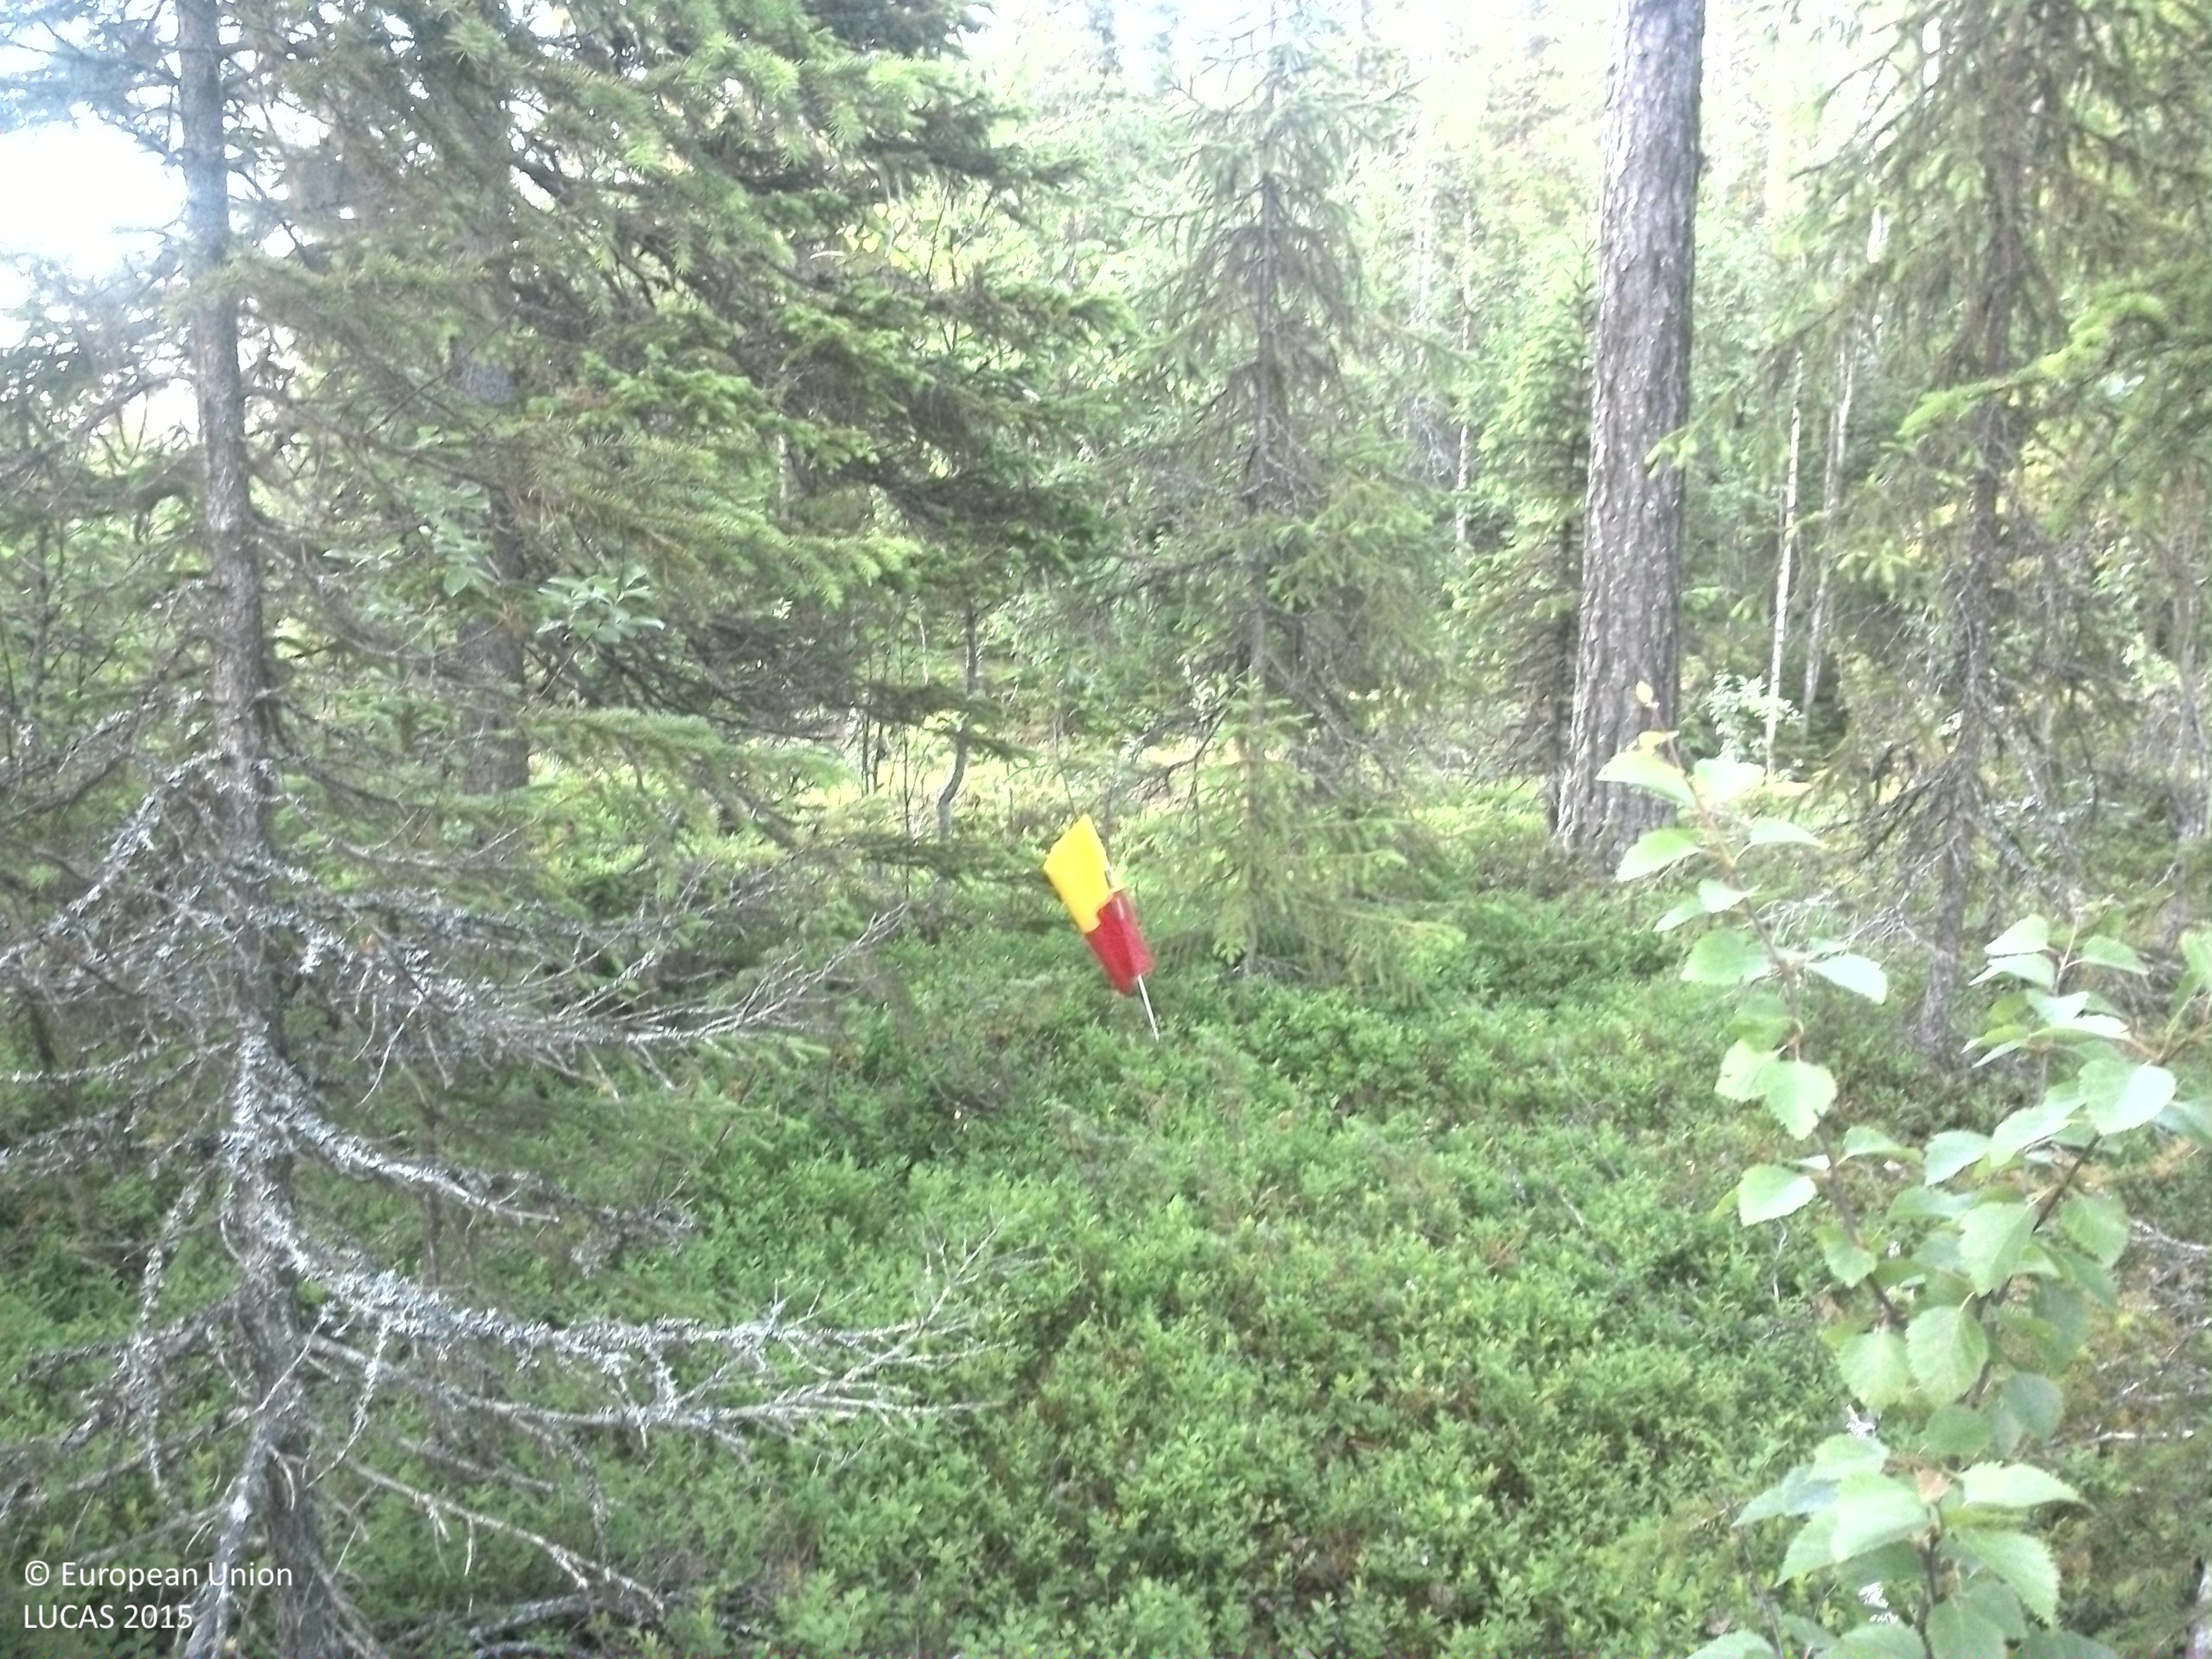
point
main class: Woodland
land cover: Other coniferous woodland
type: boreal forest
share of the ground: 50 - 75 %
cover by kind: coniferous forest trees 50 %, shrubs 35 %, lichens and mosses 10 %, broadleaved forest trees 5 %
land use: Forestry
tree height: > 5 m
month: July
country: SE
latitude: 64.5686
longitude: 15.6670
